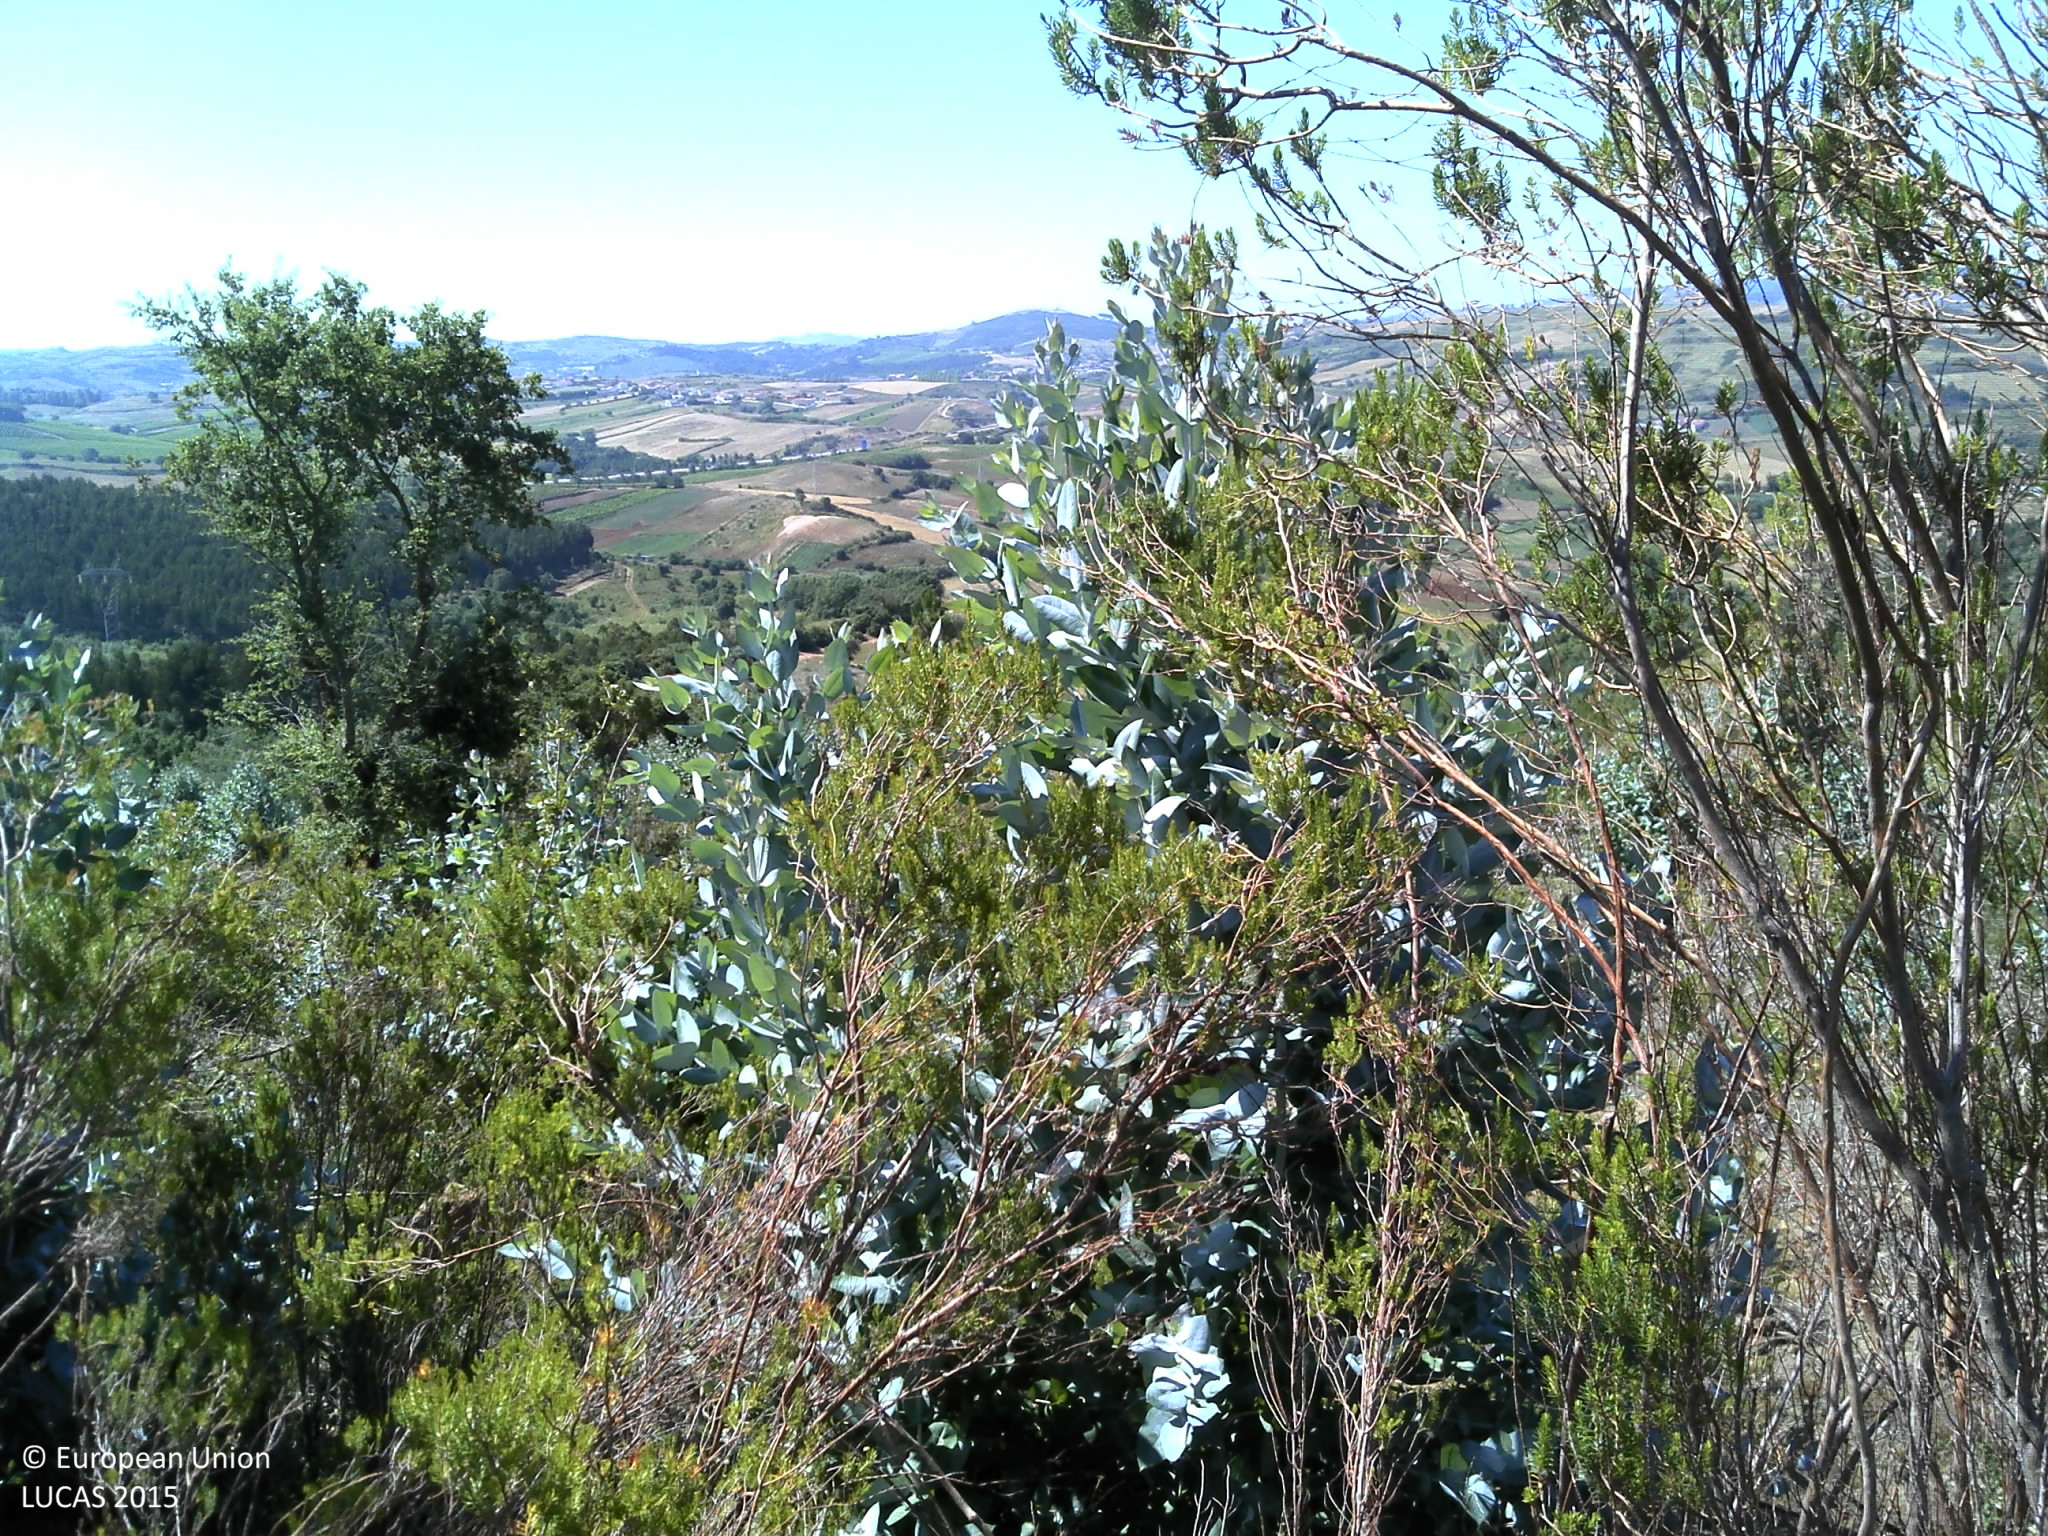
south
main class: Woodland
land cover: Broadleaved woodland
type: exotic forest
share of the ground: 10 - 25 %
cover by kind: shrubs 50 %, broadleaved forest trees 25 %, unconsolidated bare surface 25 %
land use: Forestry
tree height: < 5 m
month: June
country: PT
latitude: 39.0140
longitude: -9.2202
